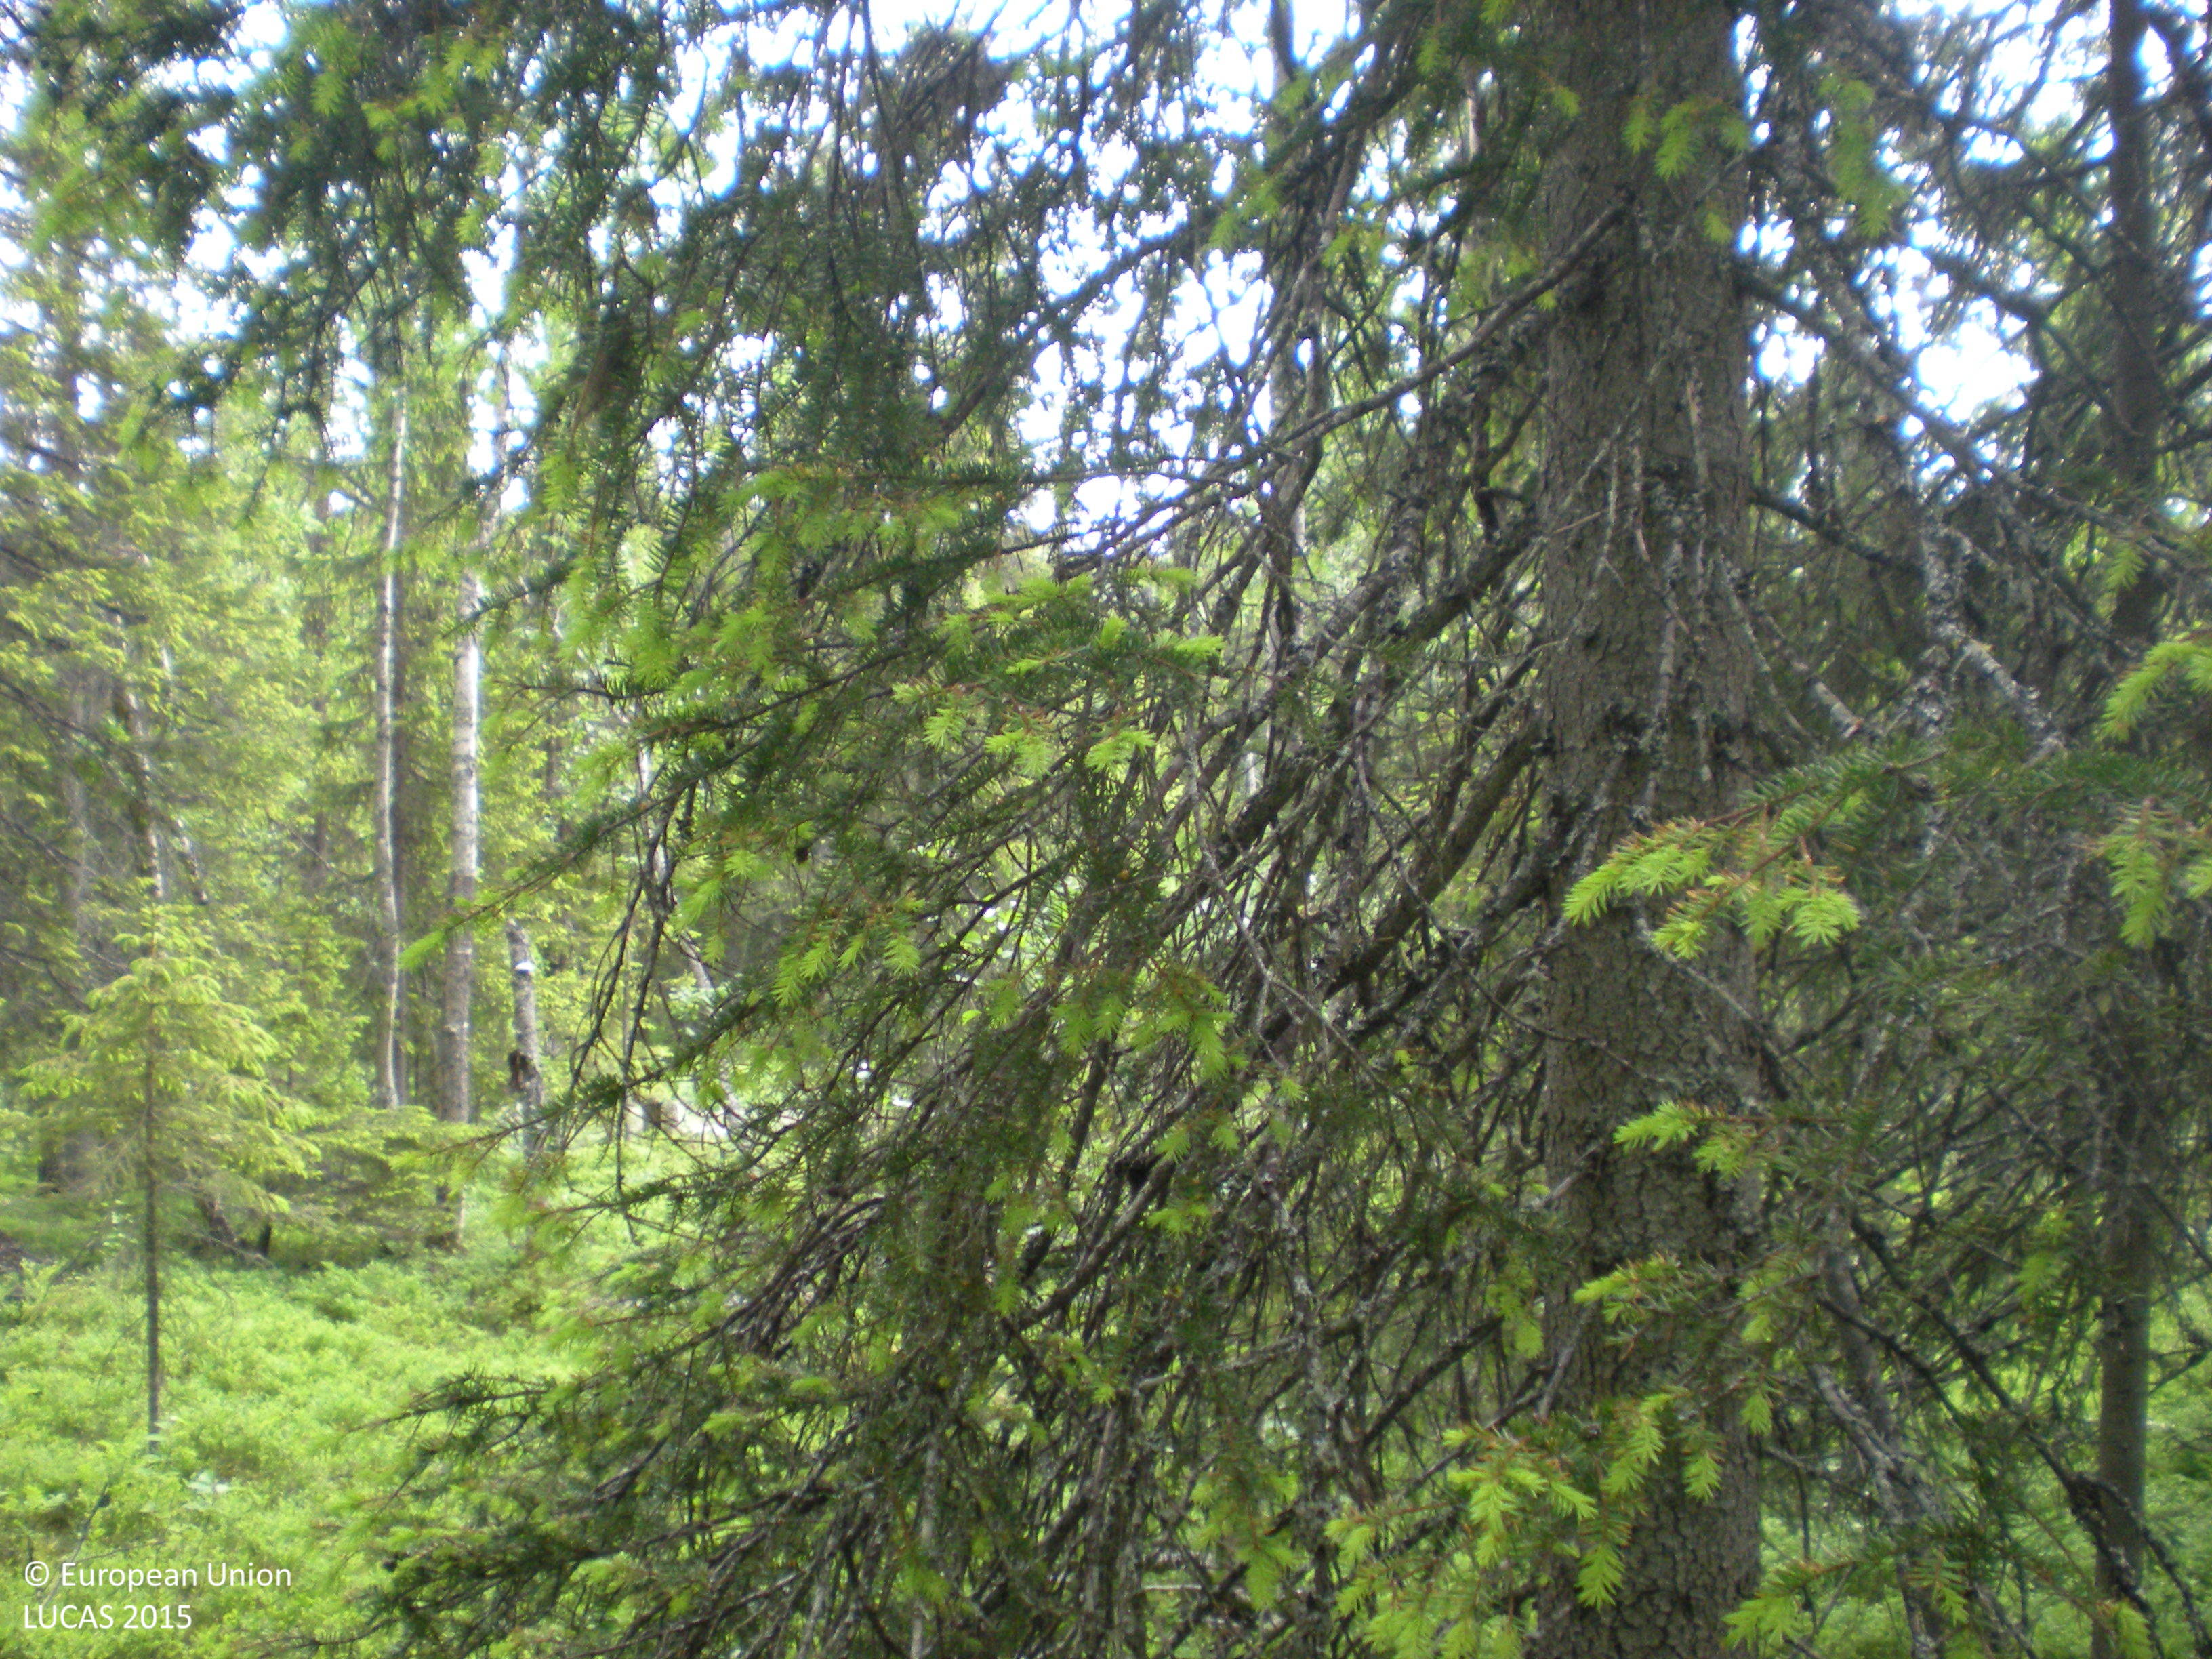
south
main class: Woodland
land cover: Spruce dominated coniferous woodland
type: boreal forest
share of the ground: 50 - 75 %
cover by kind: coniferous forest trees 60 %, shrubs 20 %, broadleaved forest trees 10 %, lichens and mosses 10 %
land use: Forestry
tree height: > 5 m
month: July
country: SE
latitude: 65.4137
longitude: 17.2198
